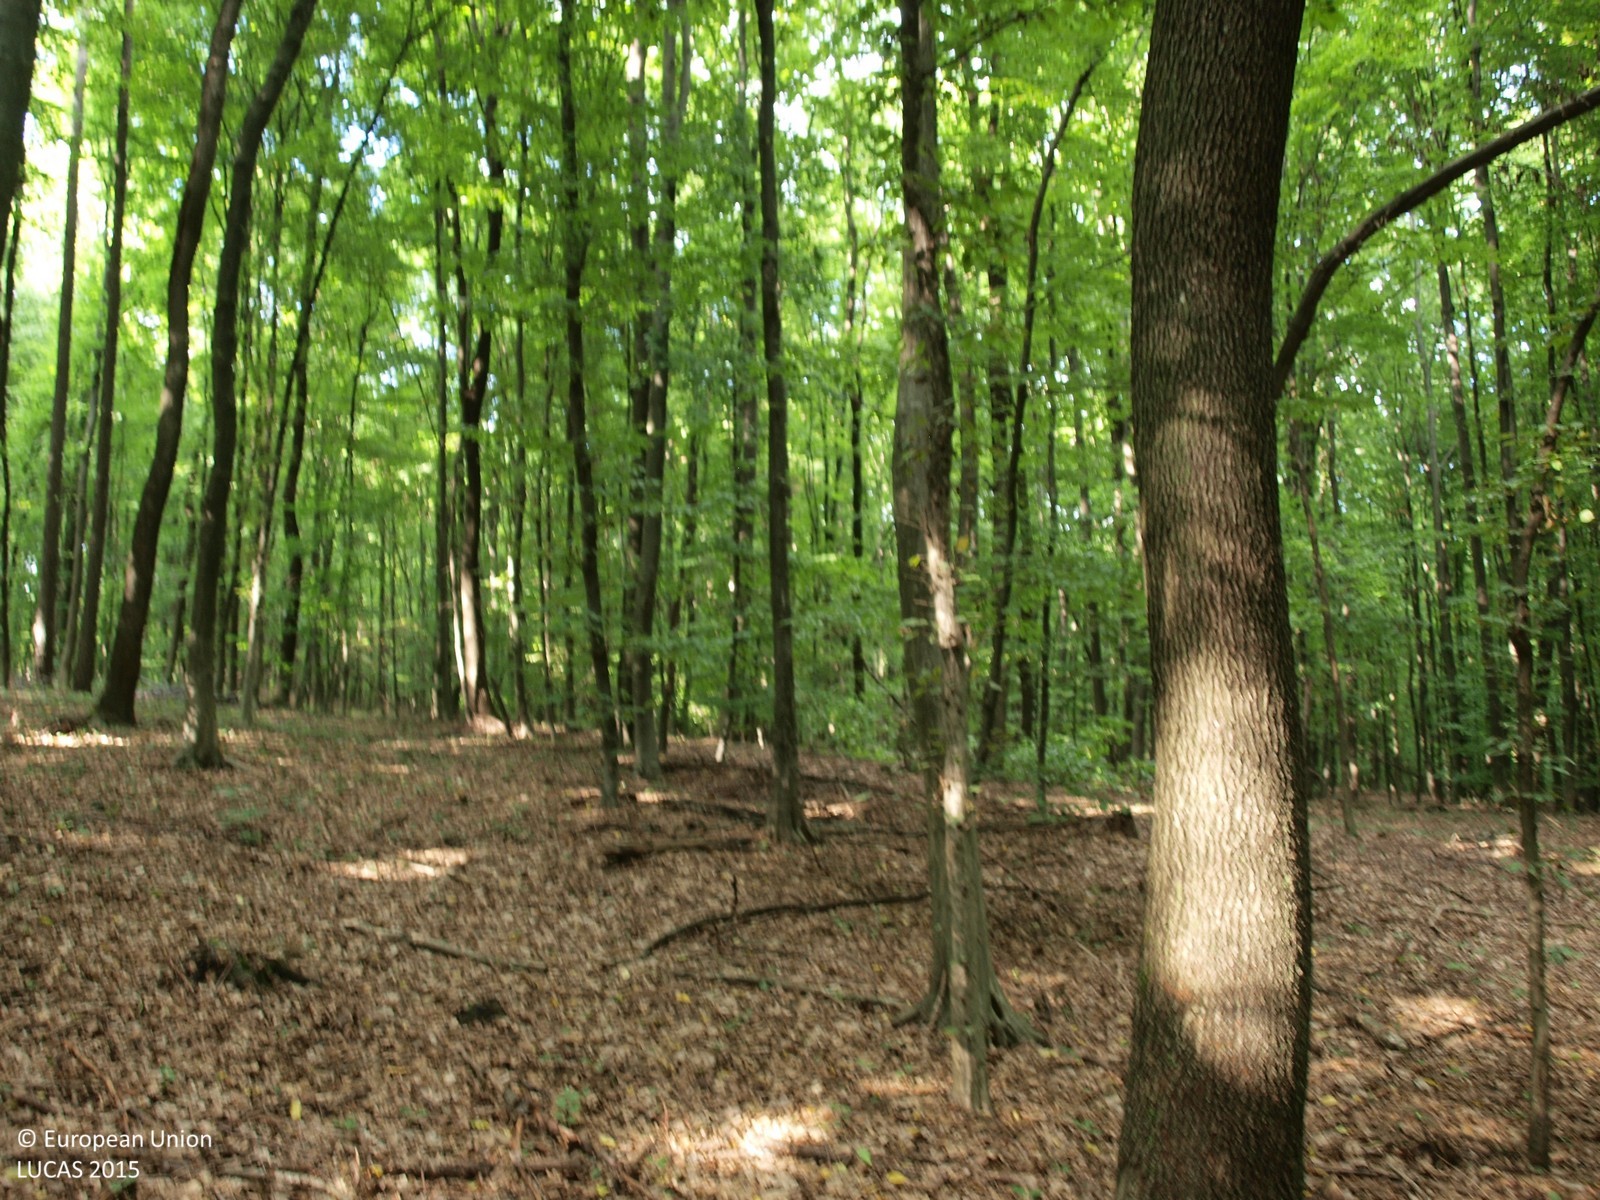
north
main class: Woodland
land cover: Broadleaved woodland
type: mesophytic deciduous forest
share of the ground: > 75 %
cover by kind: broadleaved forest trees 100 %
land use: Forestry
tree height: > 5 m
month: August
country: HR
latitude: 46.0371
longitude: 16.6287
